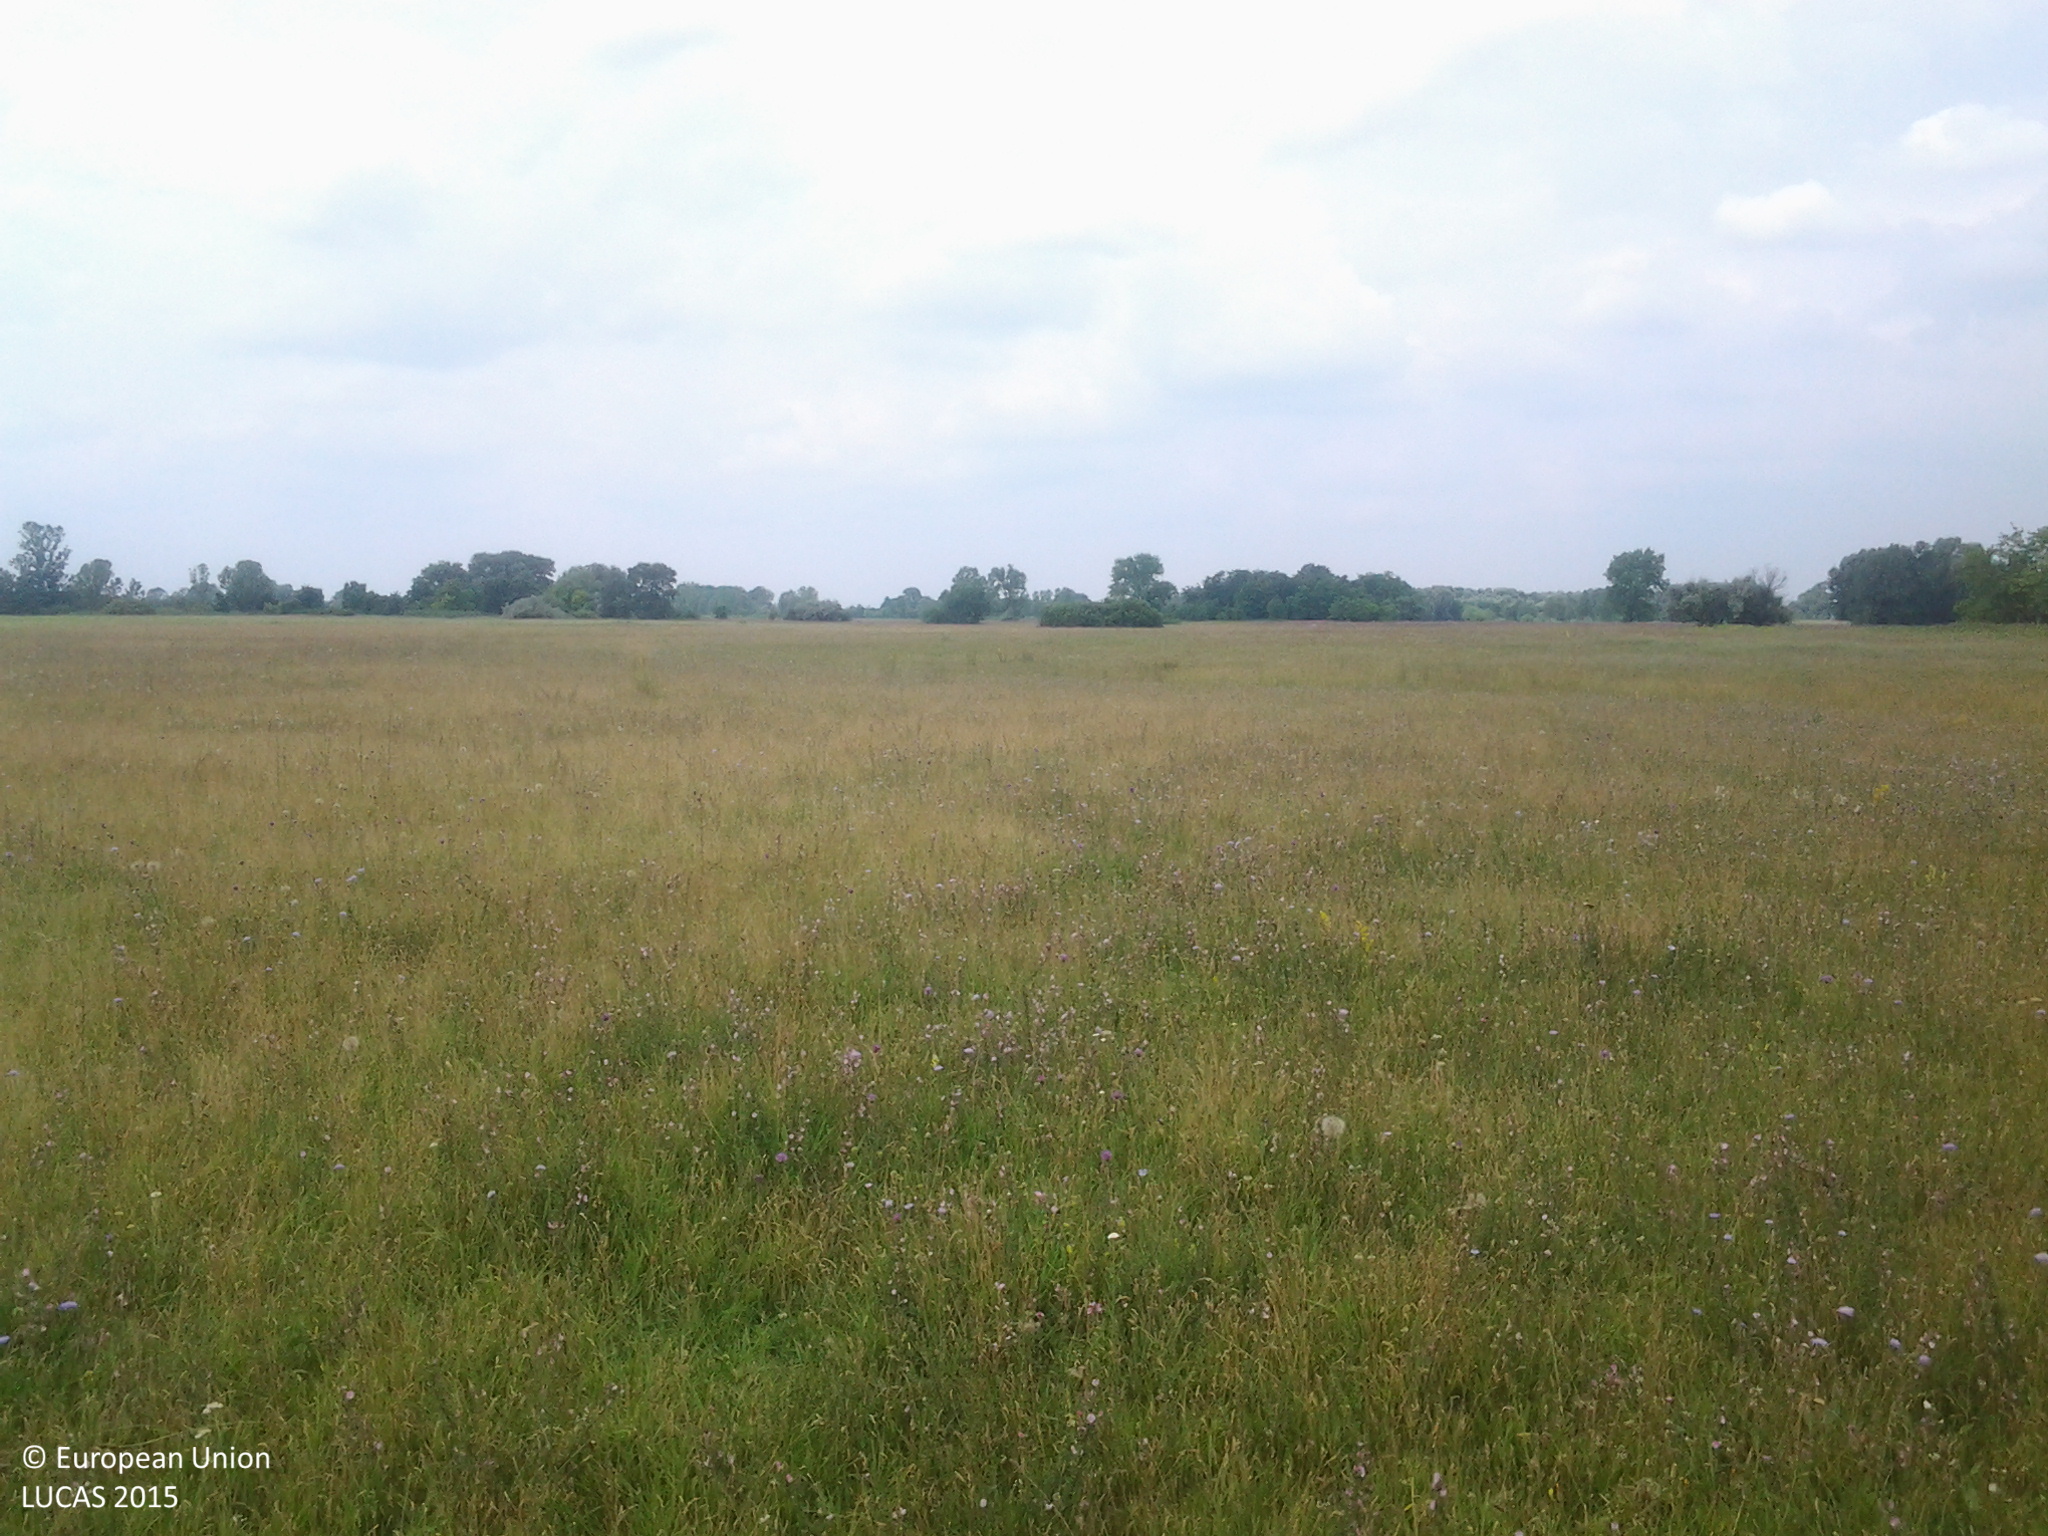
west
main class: Grassland
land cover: Spontaneously vegetated surfaces
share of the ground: > 75 %
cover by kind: herbaceous plants 100 %
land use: Semi-natural and natural areas not in use
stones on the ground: < 10 %
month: June
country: HU
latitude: 46.7988
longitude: 19.2801
